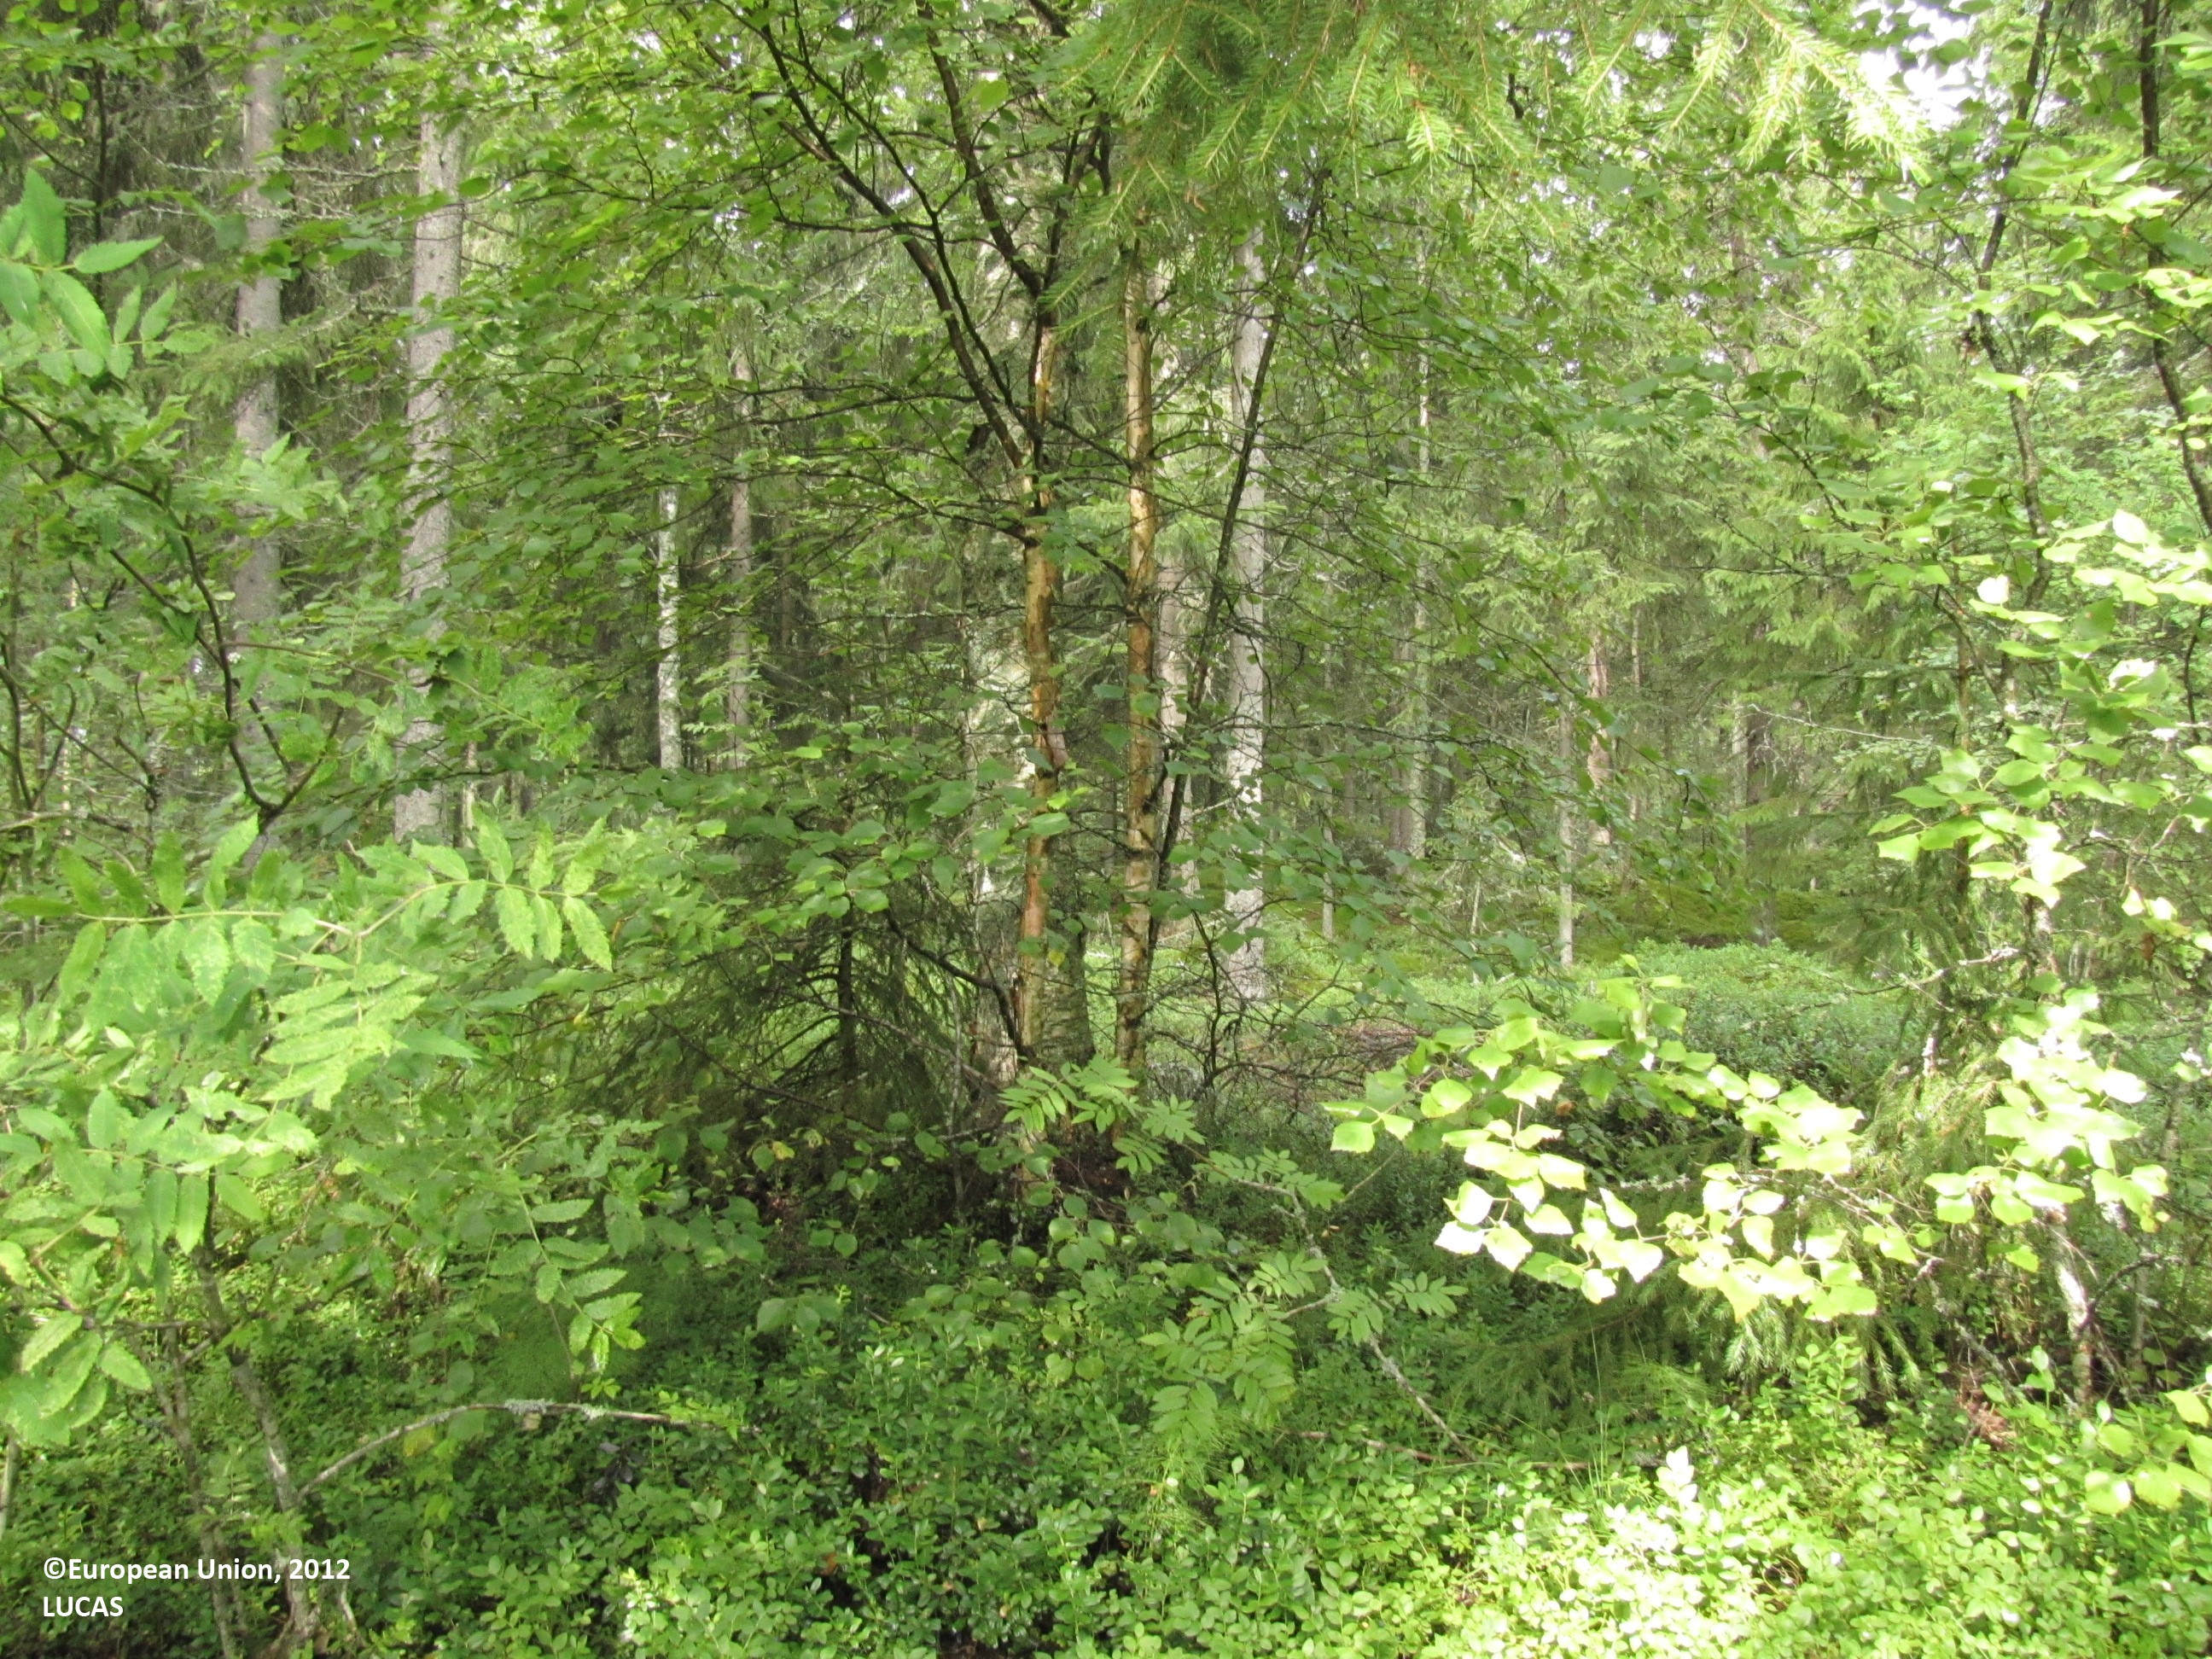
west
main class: Woodland
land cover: Pine dominated mixed woodland
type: boreal forest
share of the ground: 25 - 50 %
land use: Forestry
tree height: > 5 m
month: July
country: FI
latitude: 62.2036
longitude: 23.0801
